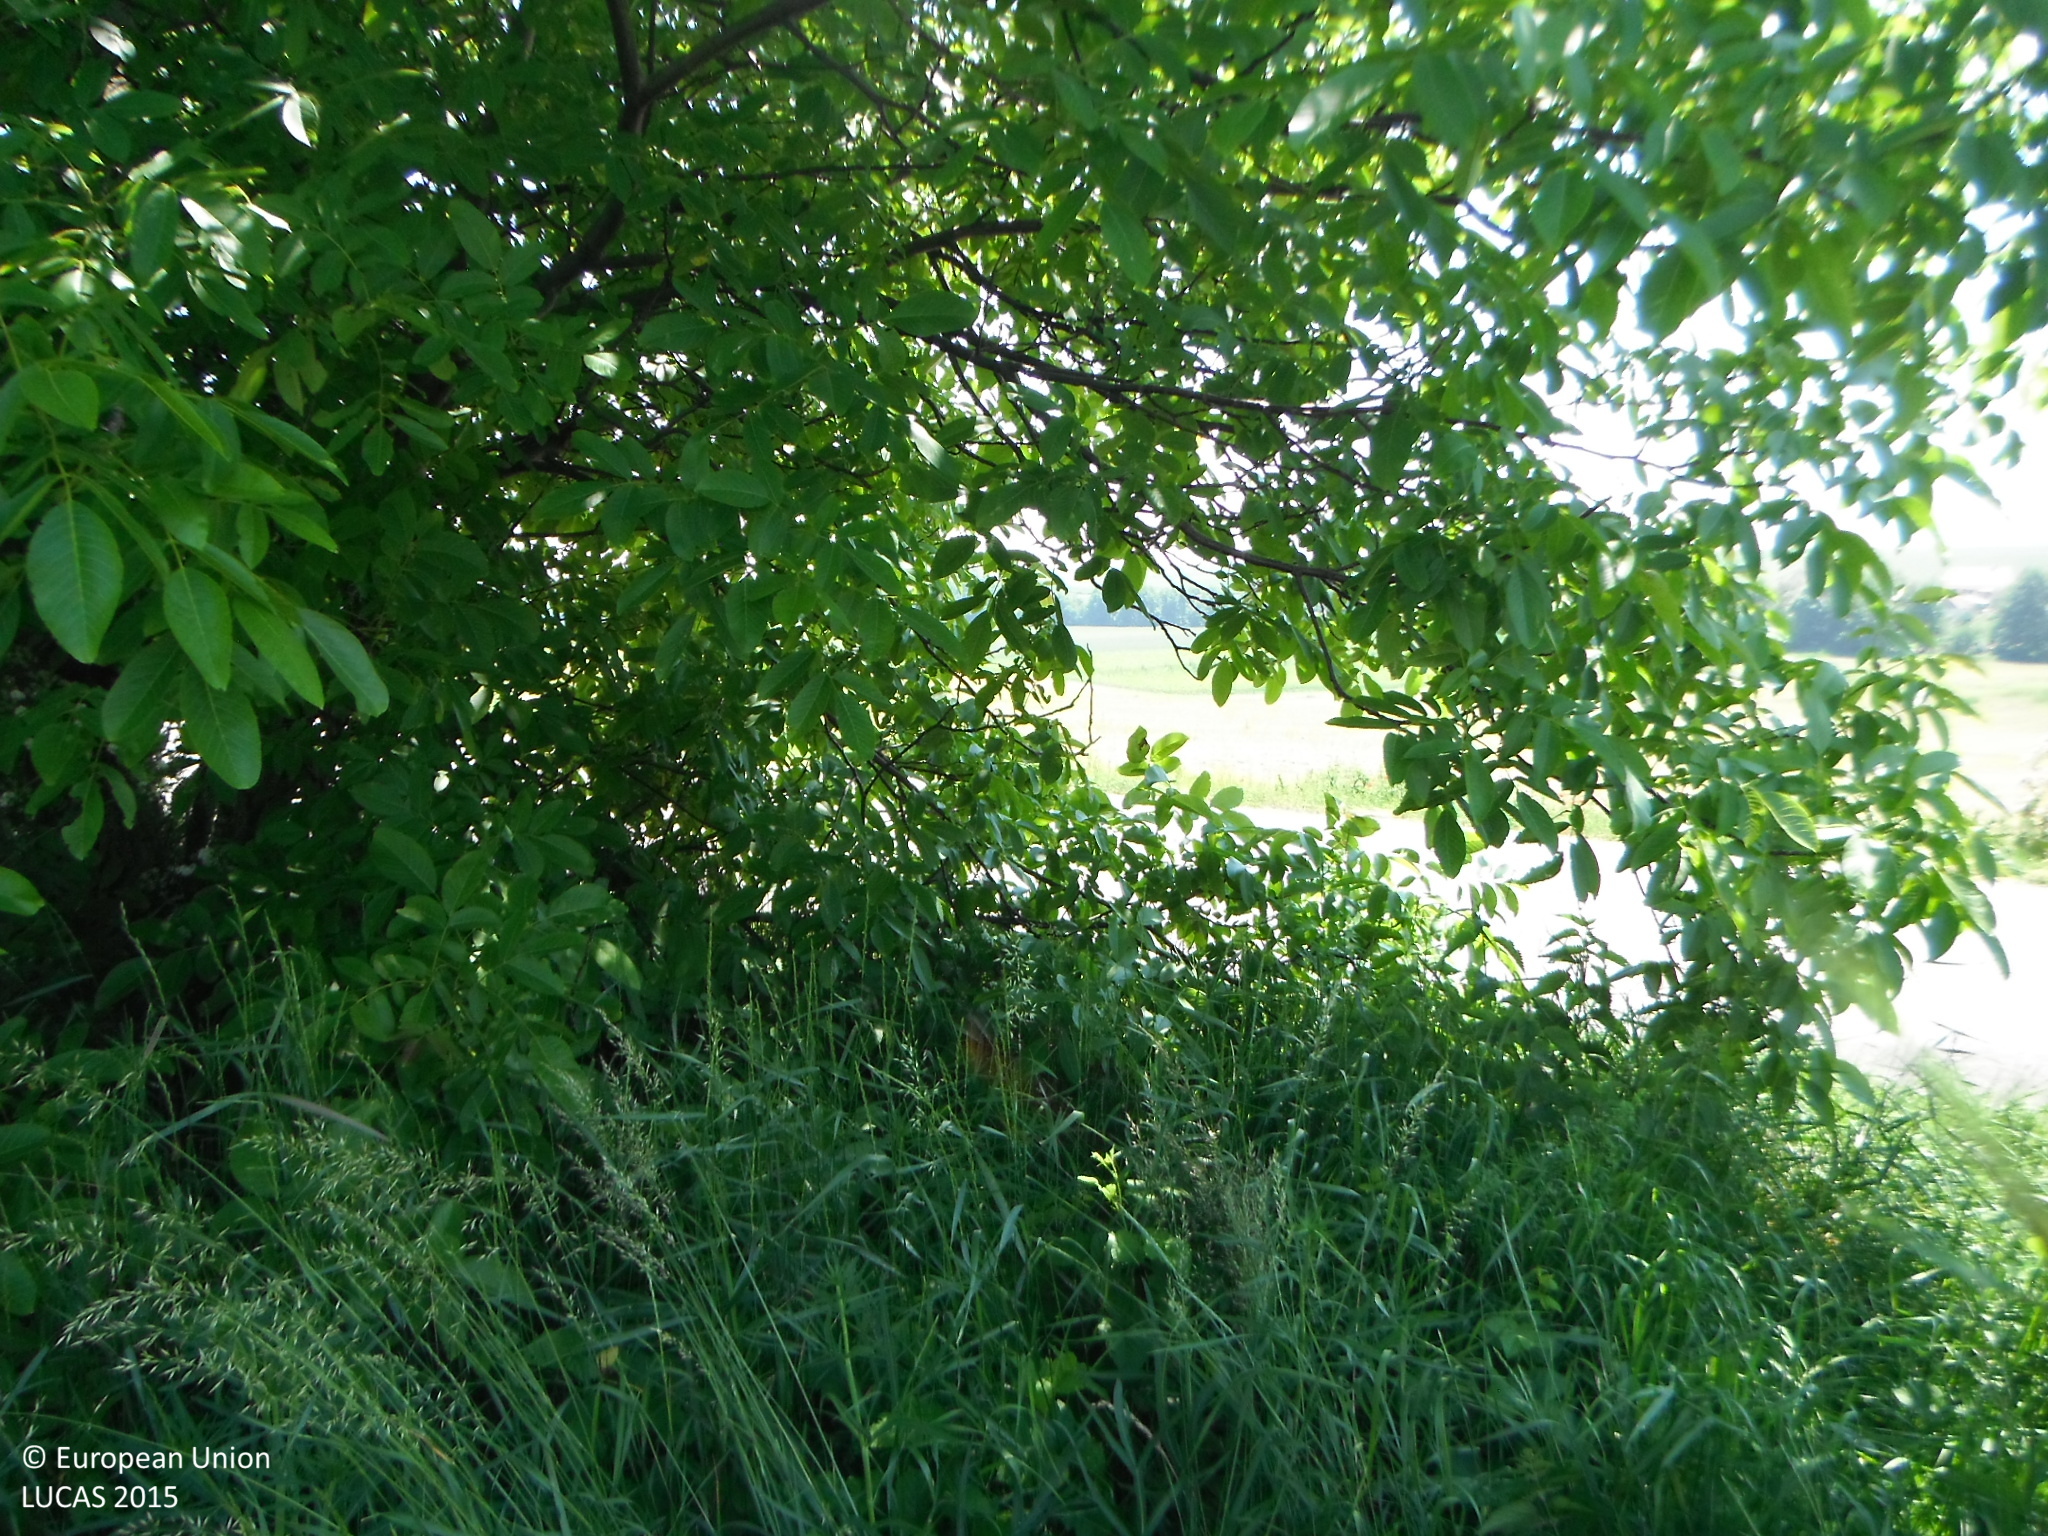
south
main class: Cropland
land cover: Barley
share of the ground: > 75 %
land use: Agriculture (excluding fallow land and kitchen gardens)
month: June
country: SK
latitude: 48.3529
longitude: 17.4185
